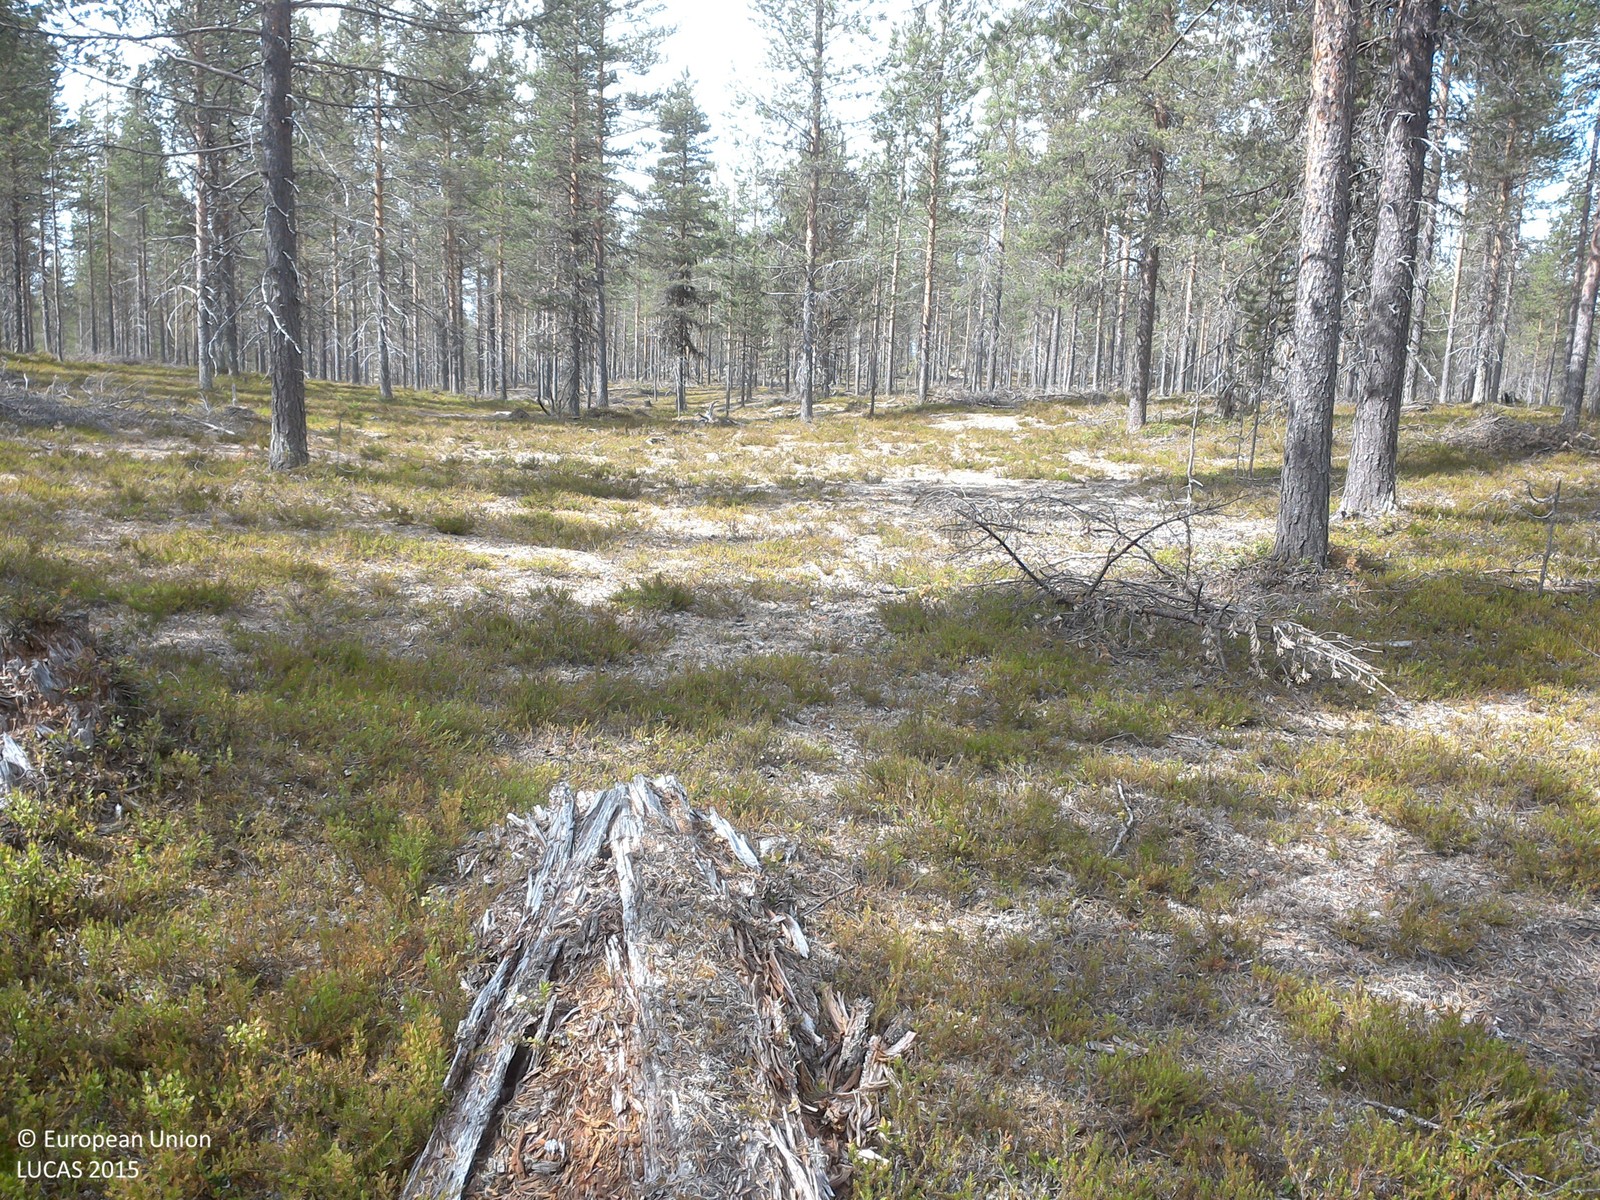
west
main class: Woodland
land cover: Pine dominated coniferous woodland
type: boreal forest
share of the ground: 10 - 25 %
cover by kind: shrubs 40 %, lichens and mosses 40 %, coniferous forest trees 20 %
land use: Forestry
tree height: > 5 m
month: July
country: SE
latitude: 67.5129
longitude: 23.3450
